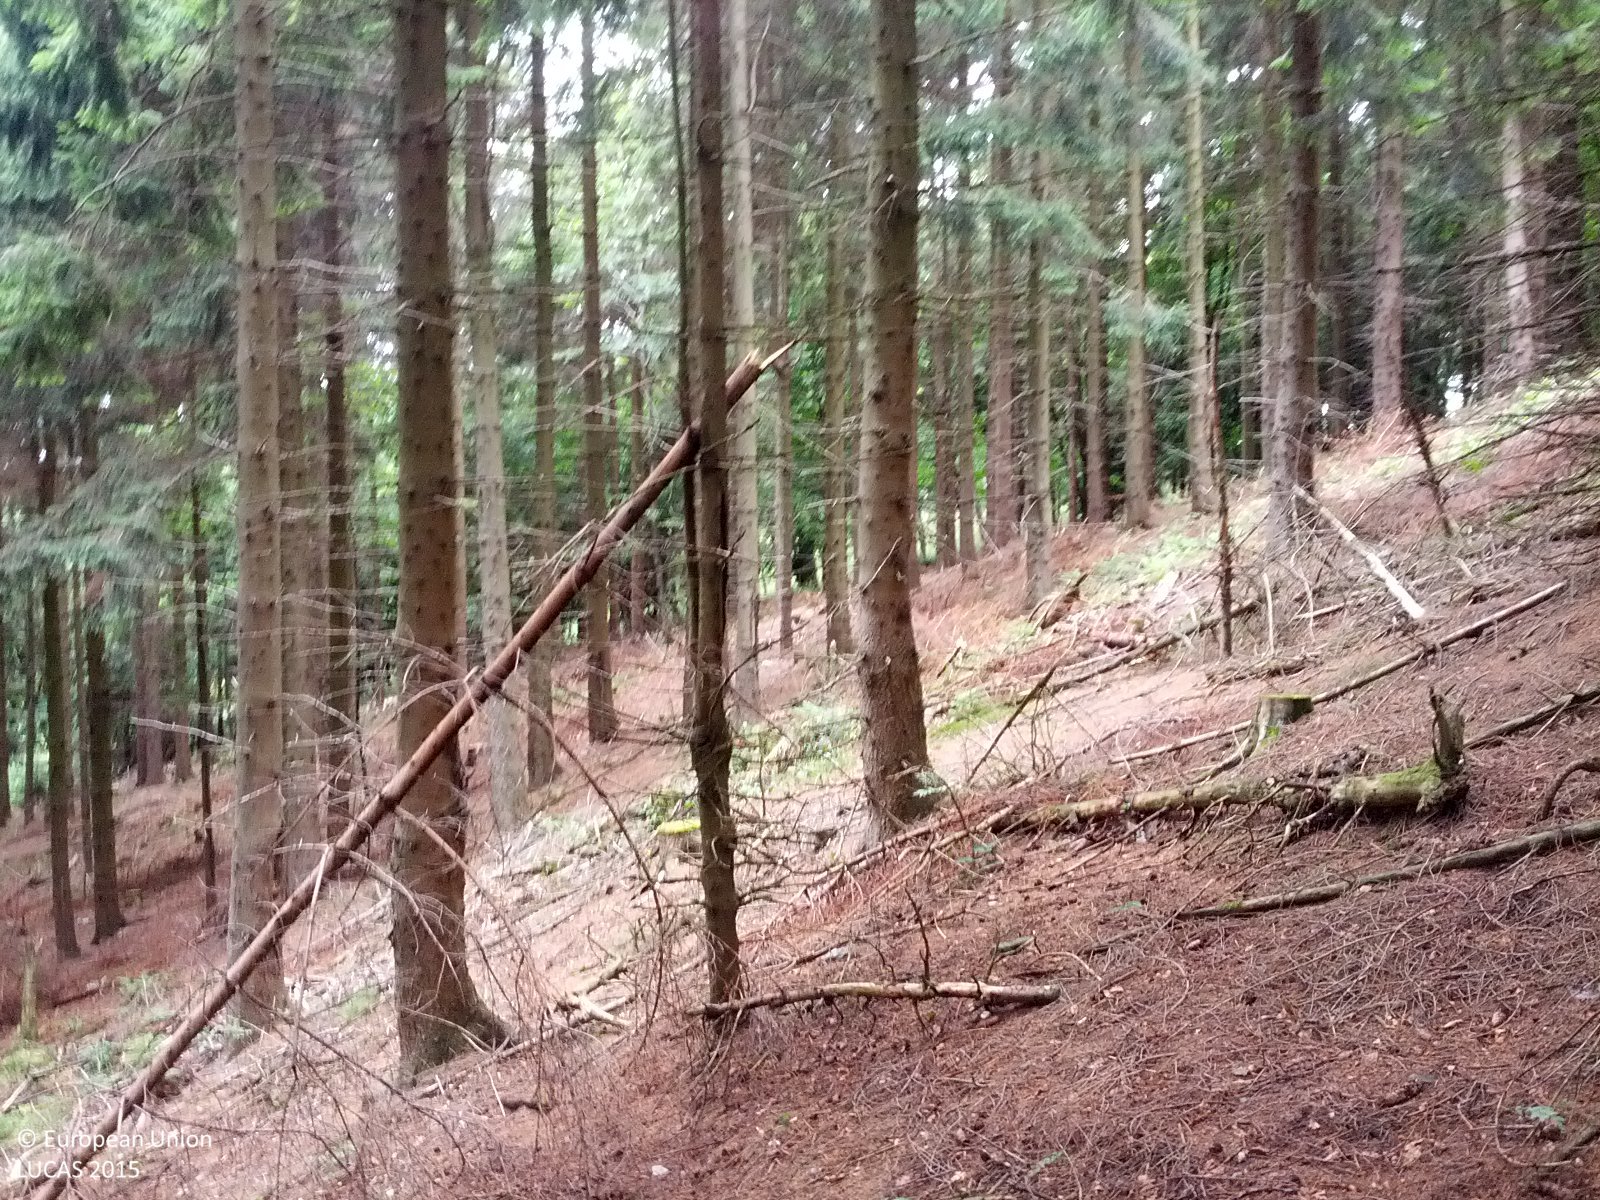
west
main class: Woodland
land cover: Spruce dominated coniferous woodland
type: alpine coniferous forest
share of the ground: > 75 %
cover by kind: coniferous forest trees 90 %, shrubs 5 %, unconsolidated bare surface 5 %
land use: Forestry
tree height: > 5 m
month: July
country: AT
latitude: 47.3501
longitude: 16.4234
